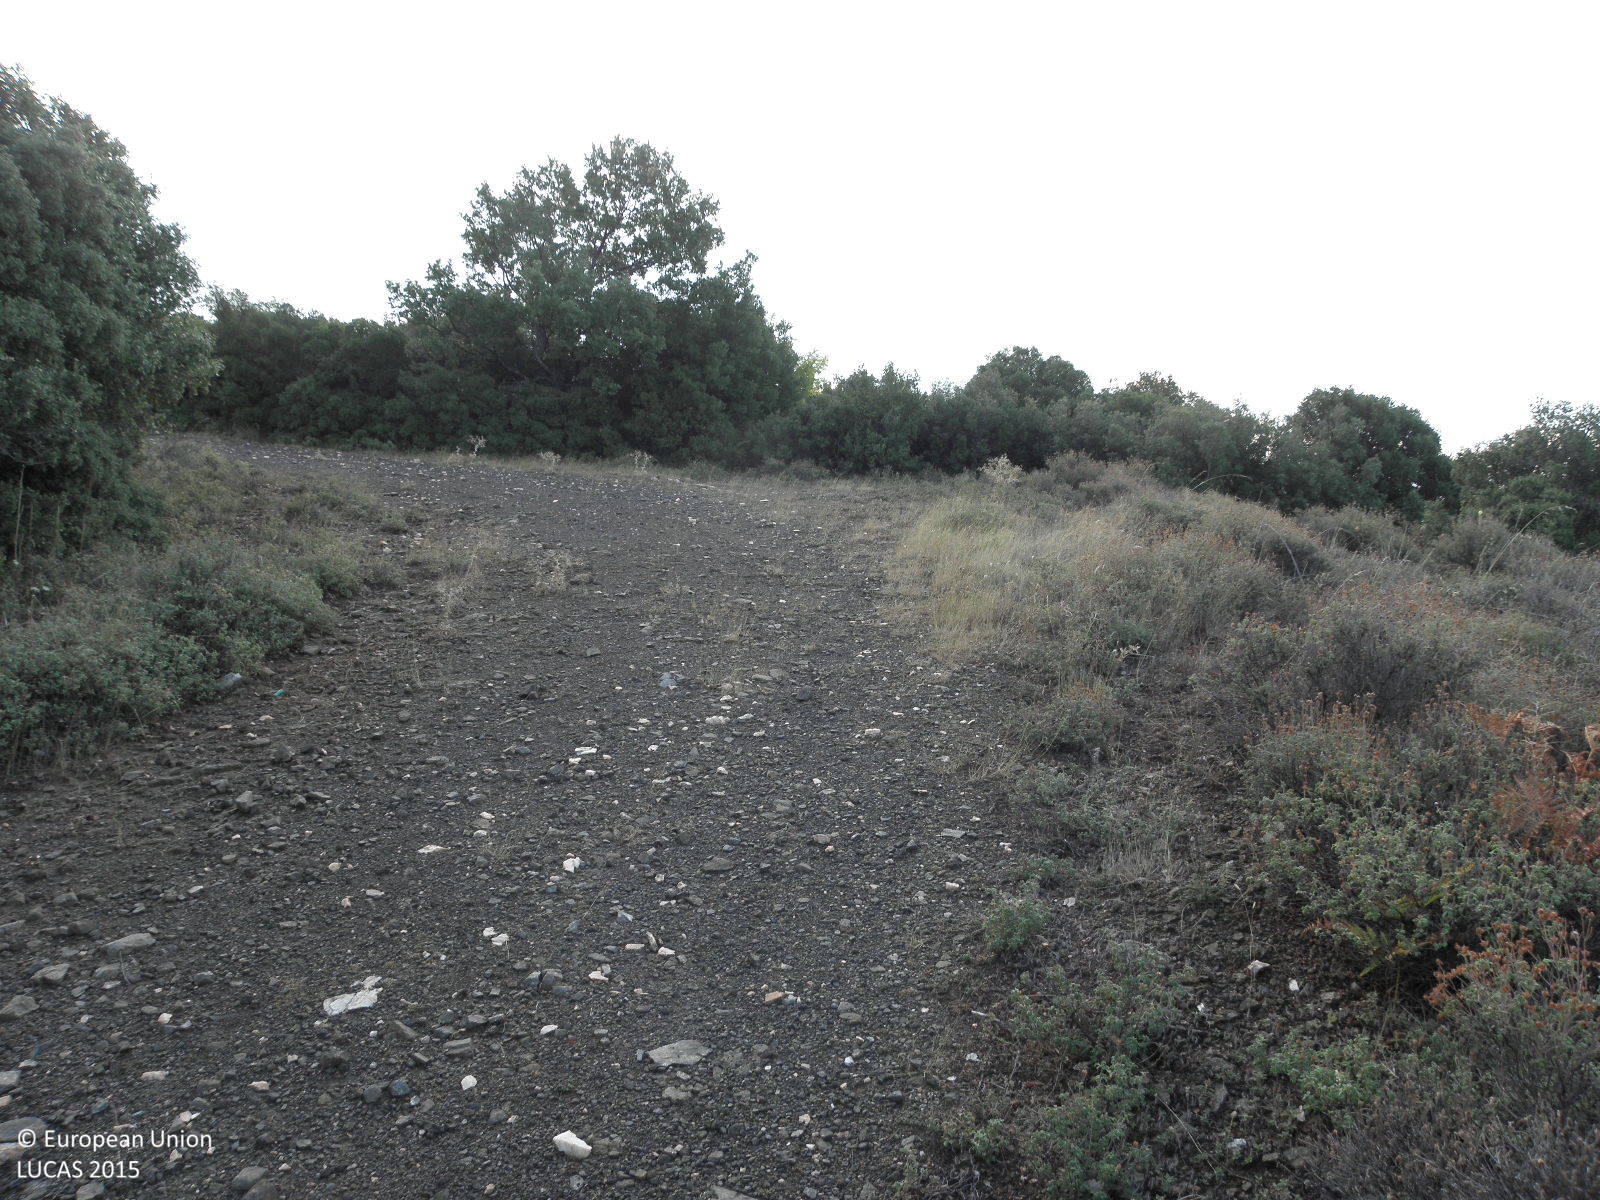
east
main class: Shrubland
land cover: Shrubland with sparse tree cover
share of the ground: > 75 %
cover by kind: shrubs 95 %, broadleaved forest trees 5 %
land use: Semi-natural and natural areas not in use
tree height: > 5 m
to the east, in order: Shrubland with sparse tree cover; Grassland without tree/shrub cover; Shrubland with sparse tree cover; Broadleaved woodland; Shrubland without tree cover; Broadleaved woodland; Rivers and streams
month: September
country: GR
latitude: 39.7429
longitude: 22.7492
